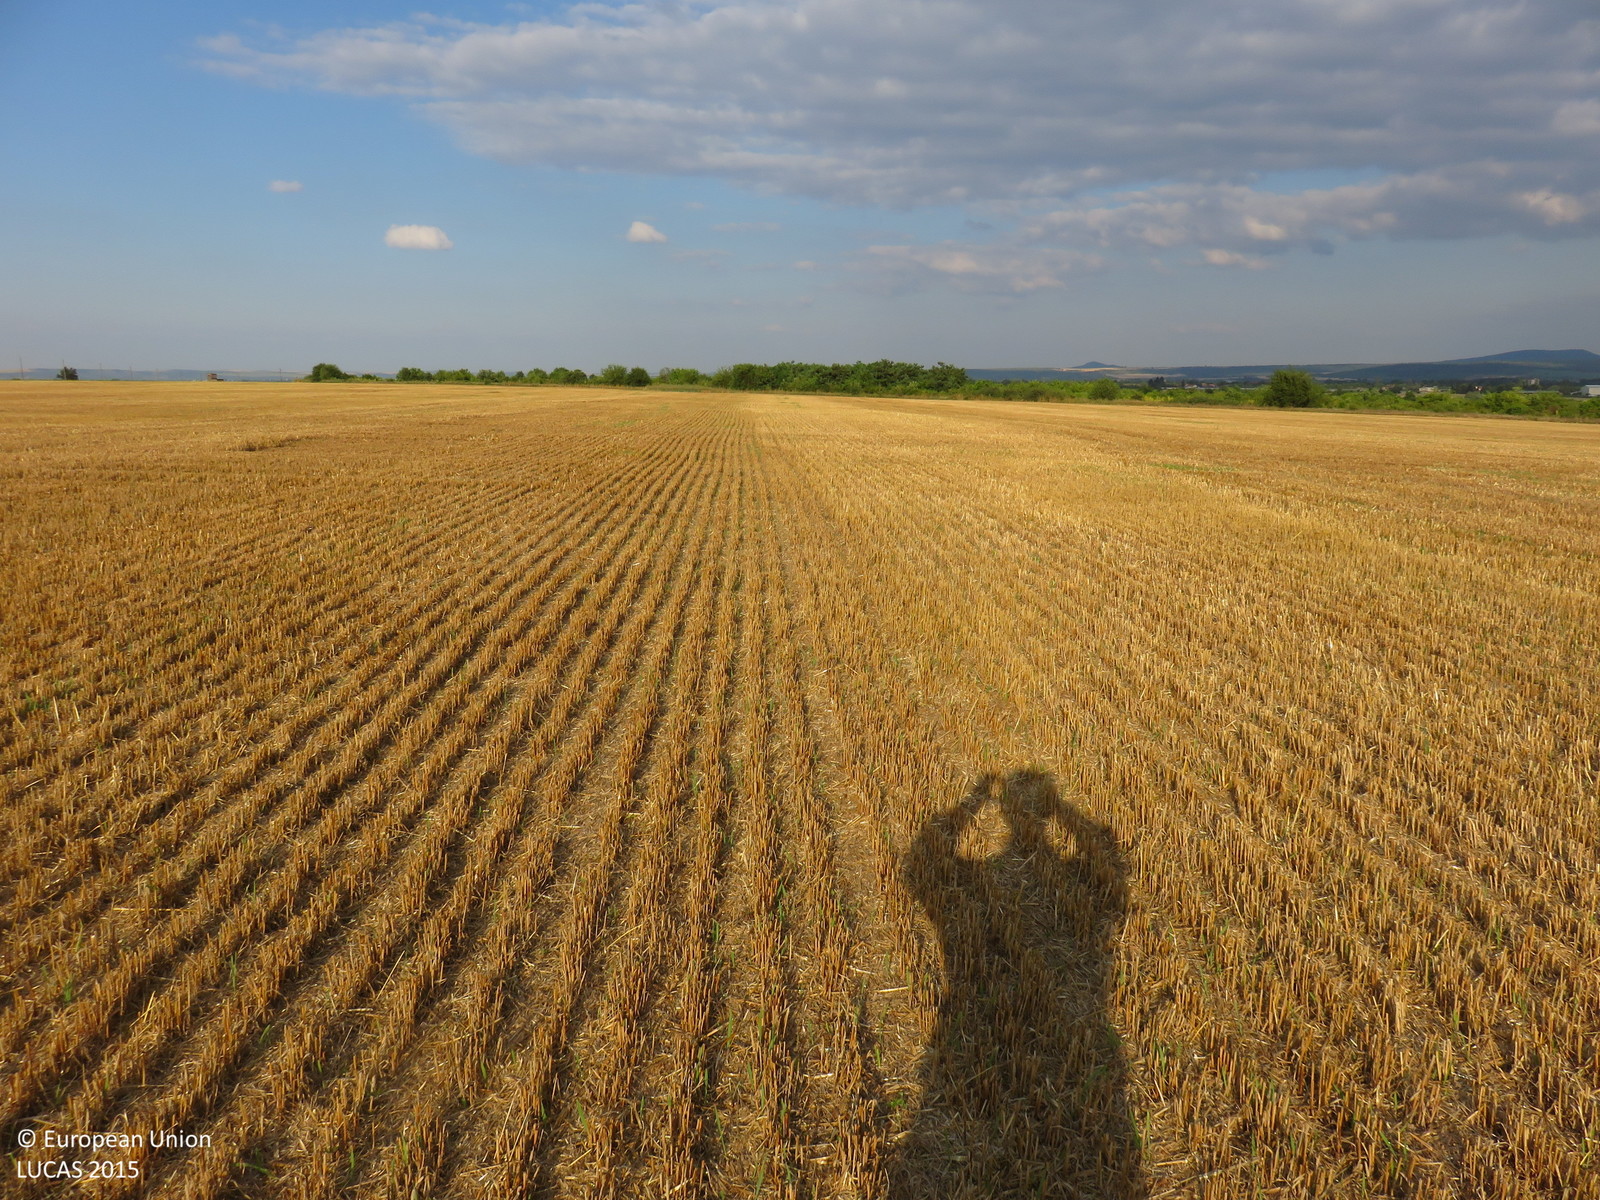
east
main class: Cropland
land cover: Barley
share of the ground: > 75 %
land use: Agriculture (excluding fallow land and kitchen gardens)
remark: Harvested field
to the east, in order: Barley; Grassland without tree/shrub cover; Other bare soil; Grass margins; Tracks; Grass margins; Shrubland with sparse tree cover
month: June
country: BG
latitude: 43.3221
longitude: 25.0278
